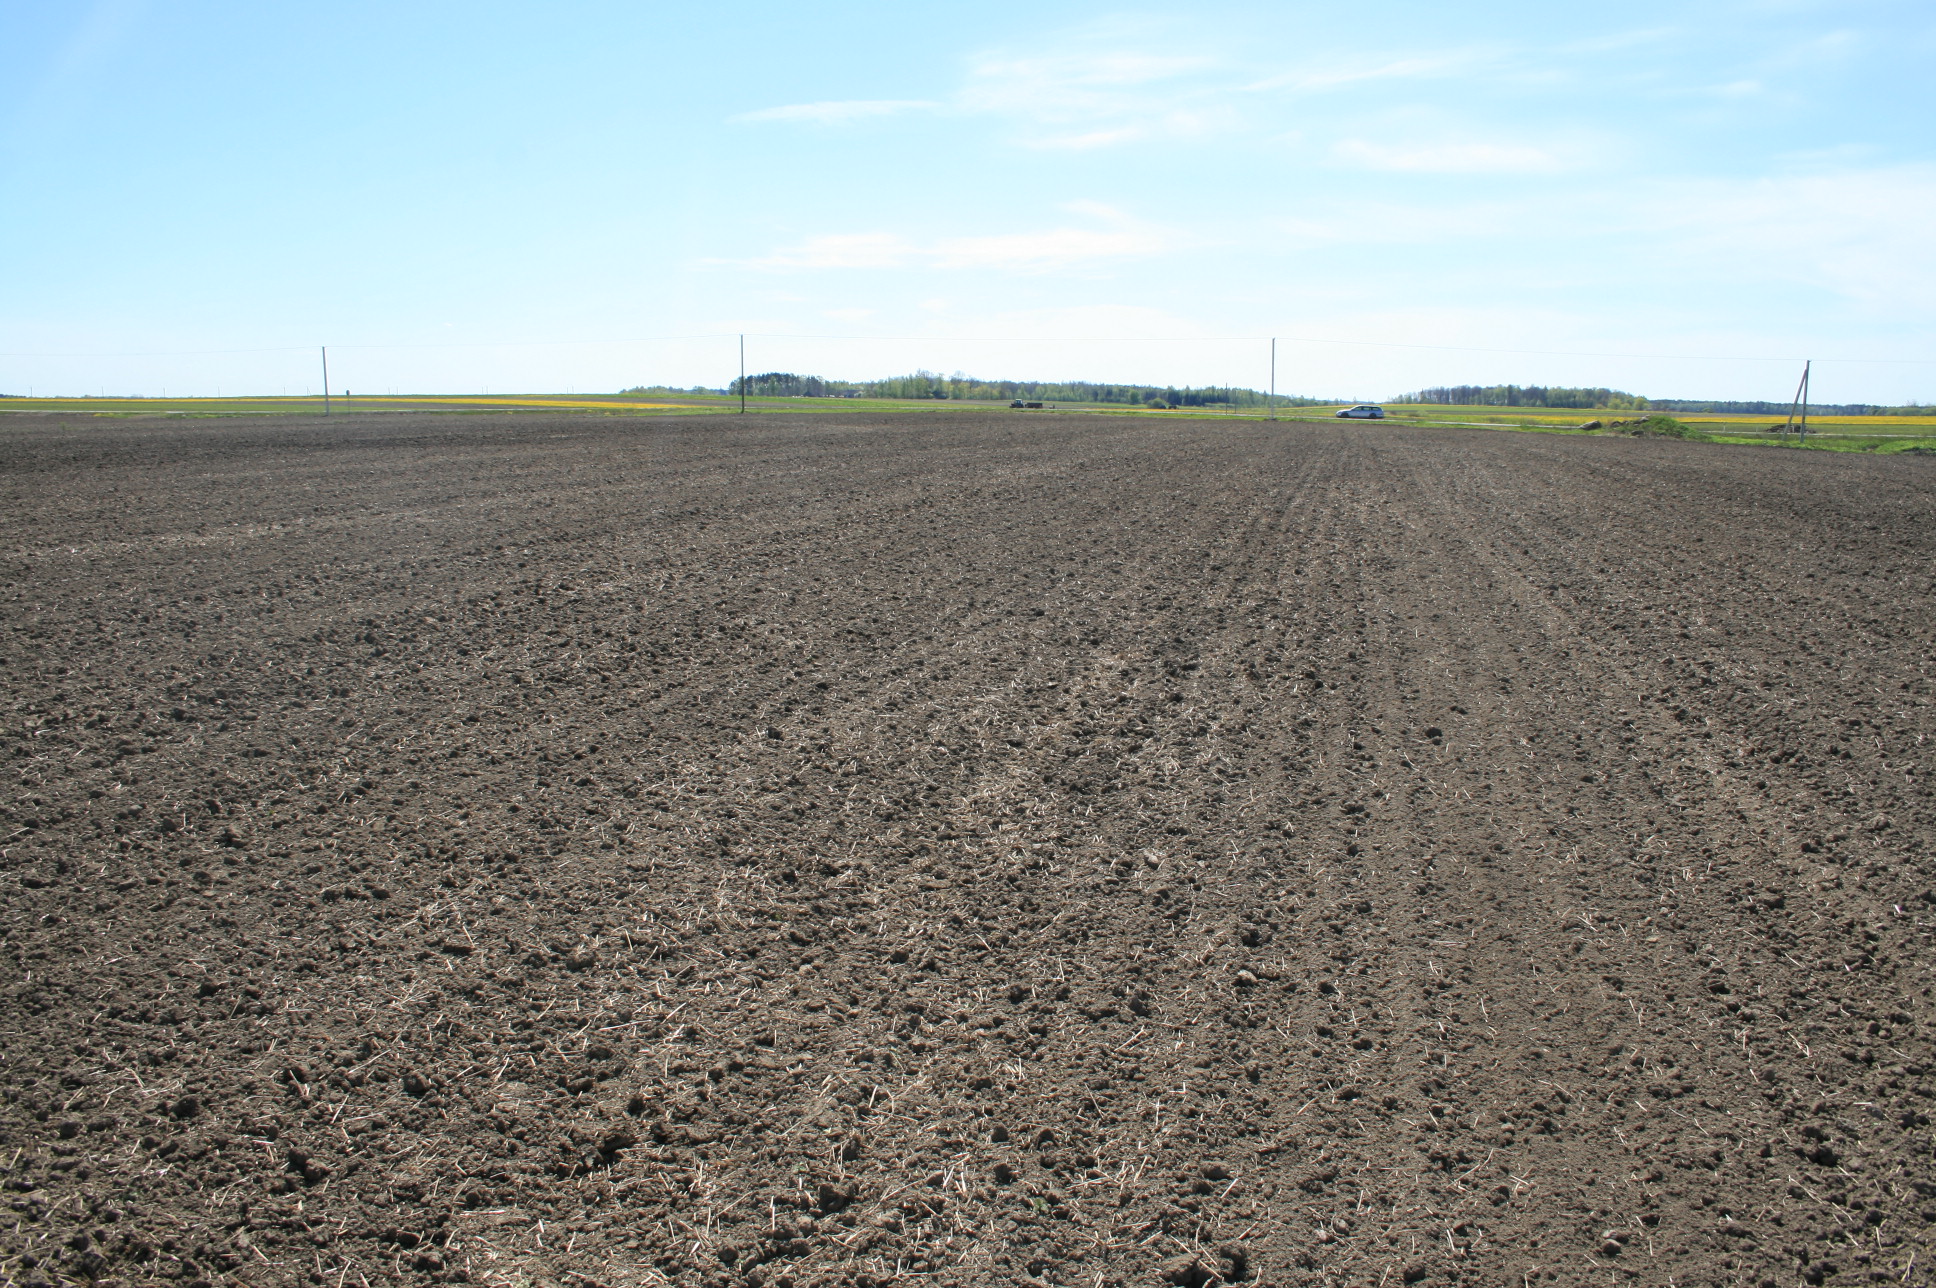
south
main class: Cropland
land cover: Barley
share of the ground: < 10 %
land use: Agriculture (excluding fallow land and kitchen gardens)
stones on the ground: < 10 %
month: May
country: LT
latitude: 56.0804
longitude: 21.3701
